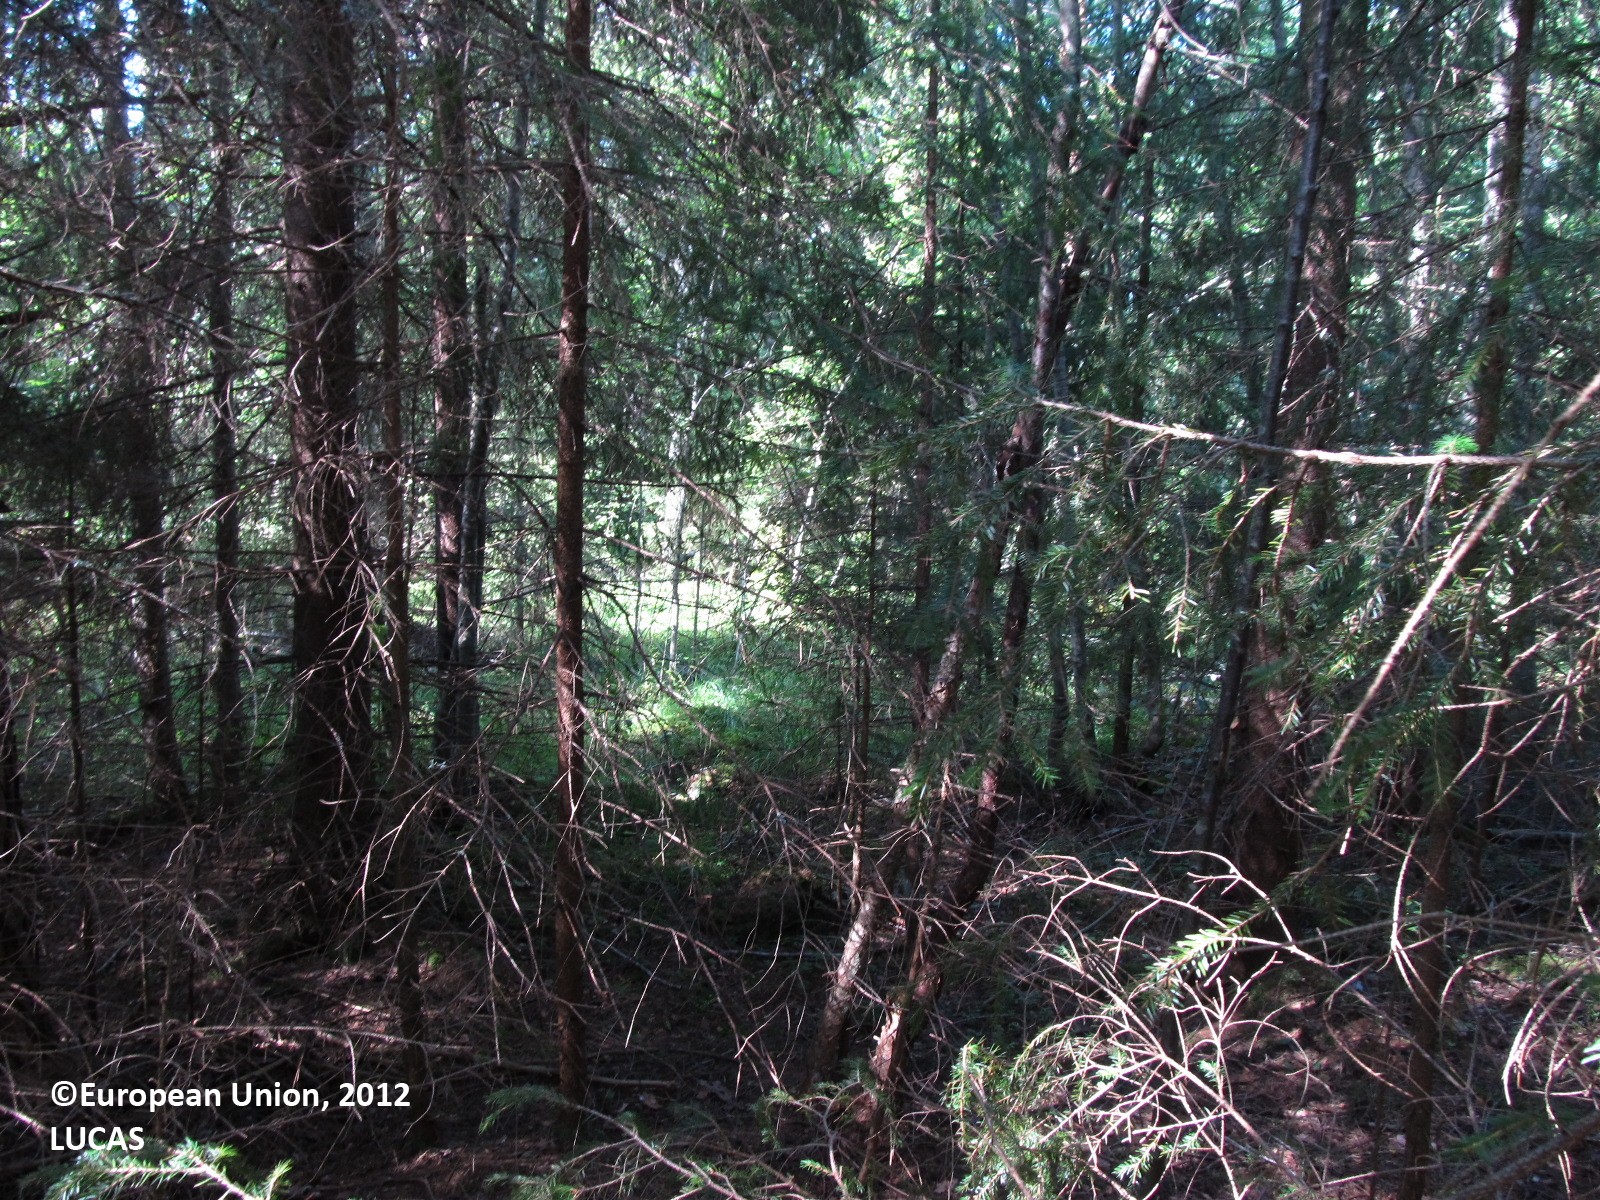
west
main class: Woodland
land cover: Spruce dominated coniferous woodland
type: boreal forest
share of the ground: 25 - 50 %
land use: Forestry
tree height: > 5 m
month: August
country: FI
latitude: 62.3274
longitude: 27.7210
